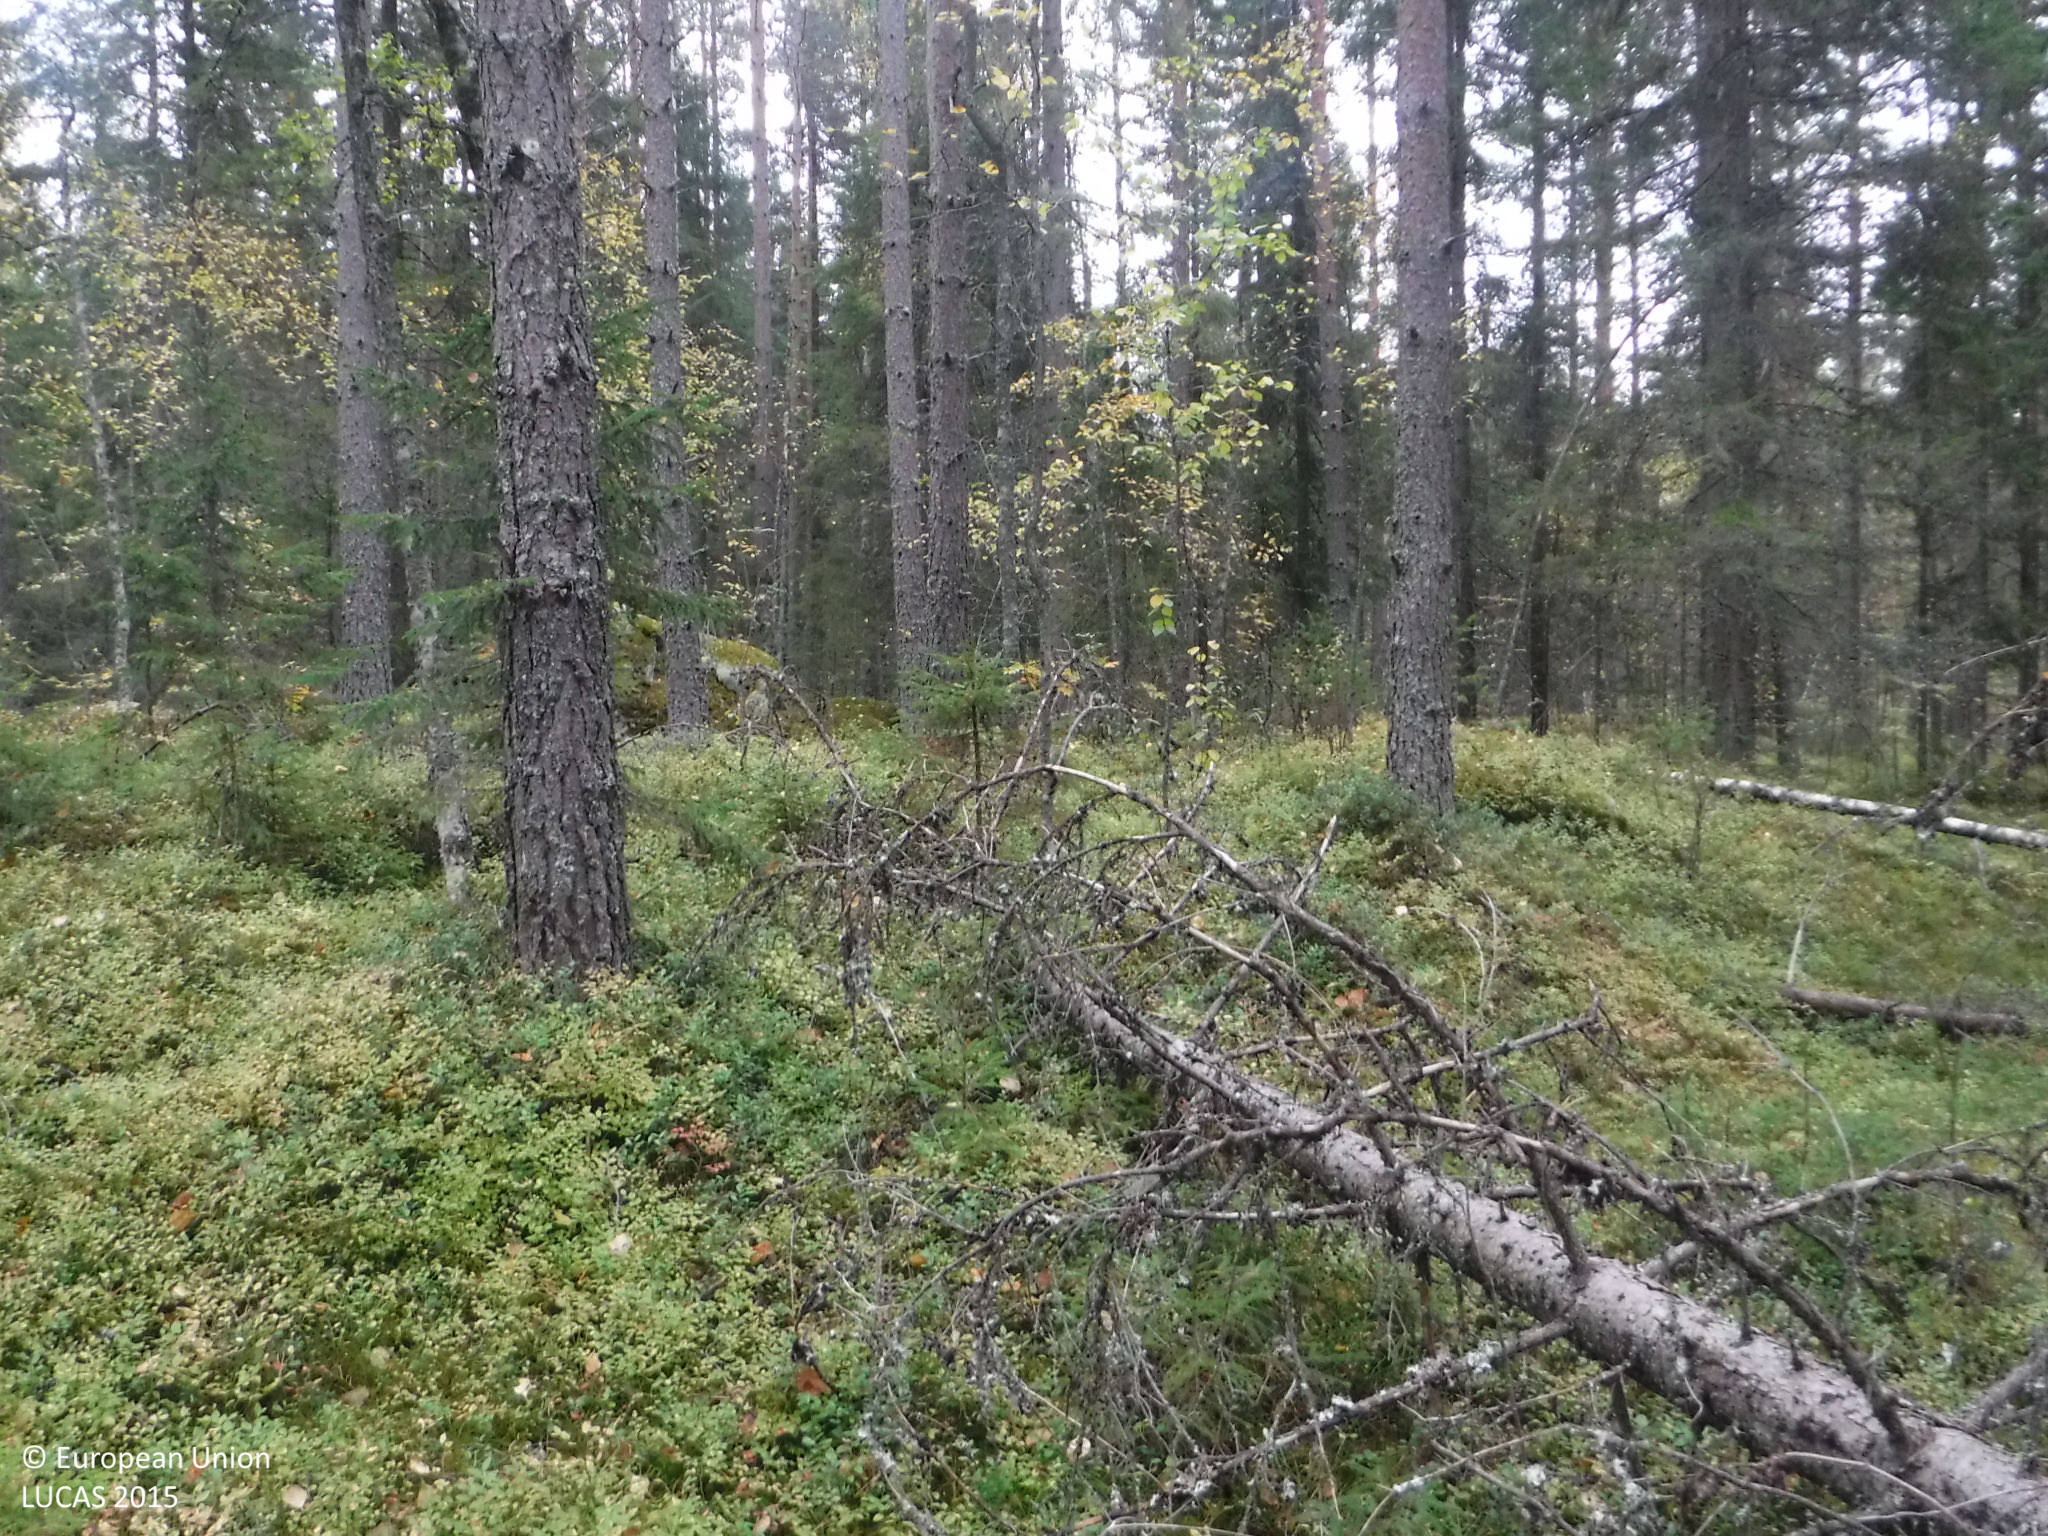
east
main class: Woodland
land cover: Other coniferous woodland
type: boreal forest
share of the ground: 50 - 75 %
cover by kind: coniferous forest trees 45 %, shrubs 25 %, lichens and mosses 25 %, broadleaved forest trees 5 %
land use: Forestry
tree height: > 5 m
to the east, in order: Other coniferous woodland; Other mixed woodland; Other coniferous woodland; Spruce dominated coniferous woodland
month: September
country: FI
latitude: 61.7509
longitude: 24.2002
